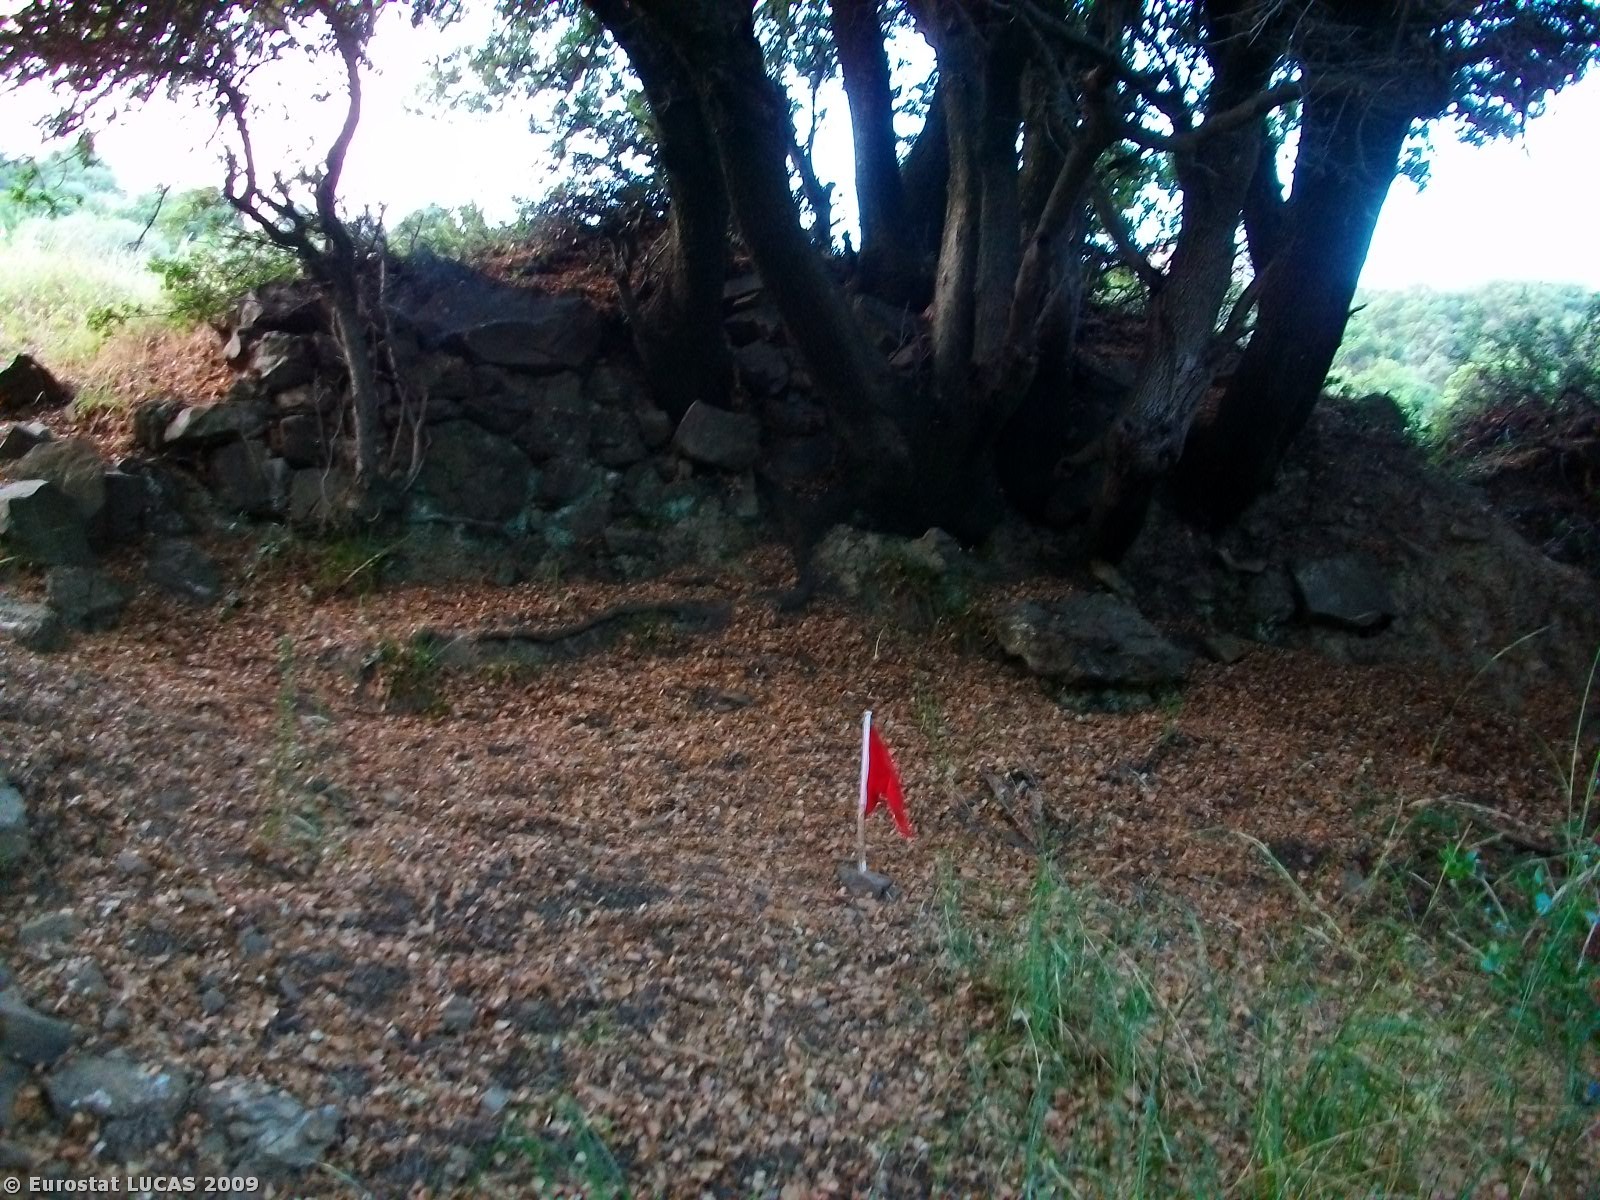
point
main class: Shrubland
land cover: Shrubland with sparse tree cover
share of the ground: > 75 %
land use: Agriculture (excluding fallow land and kitchen gardens)
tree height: < 5 m
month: July
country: GR
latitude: 38.4303
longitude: 22.1495
